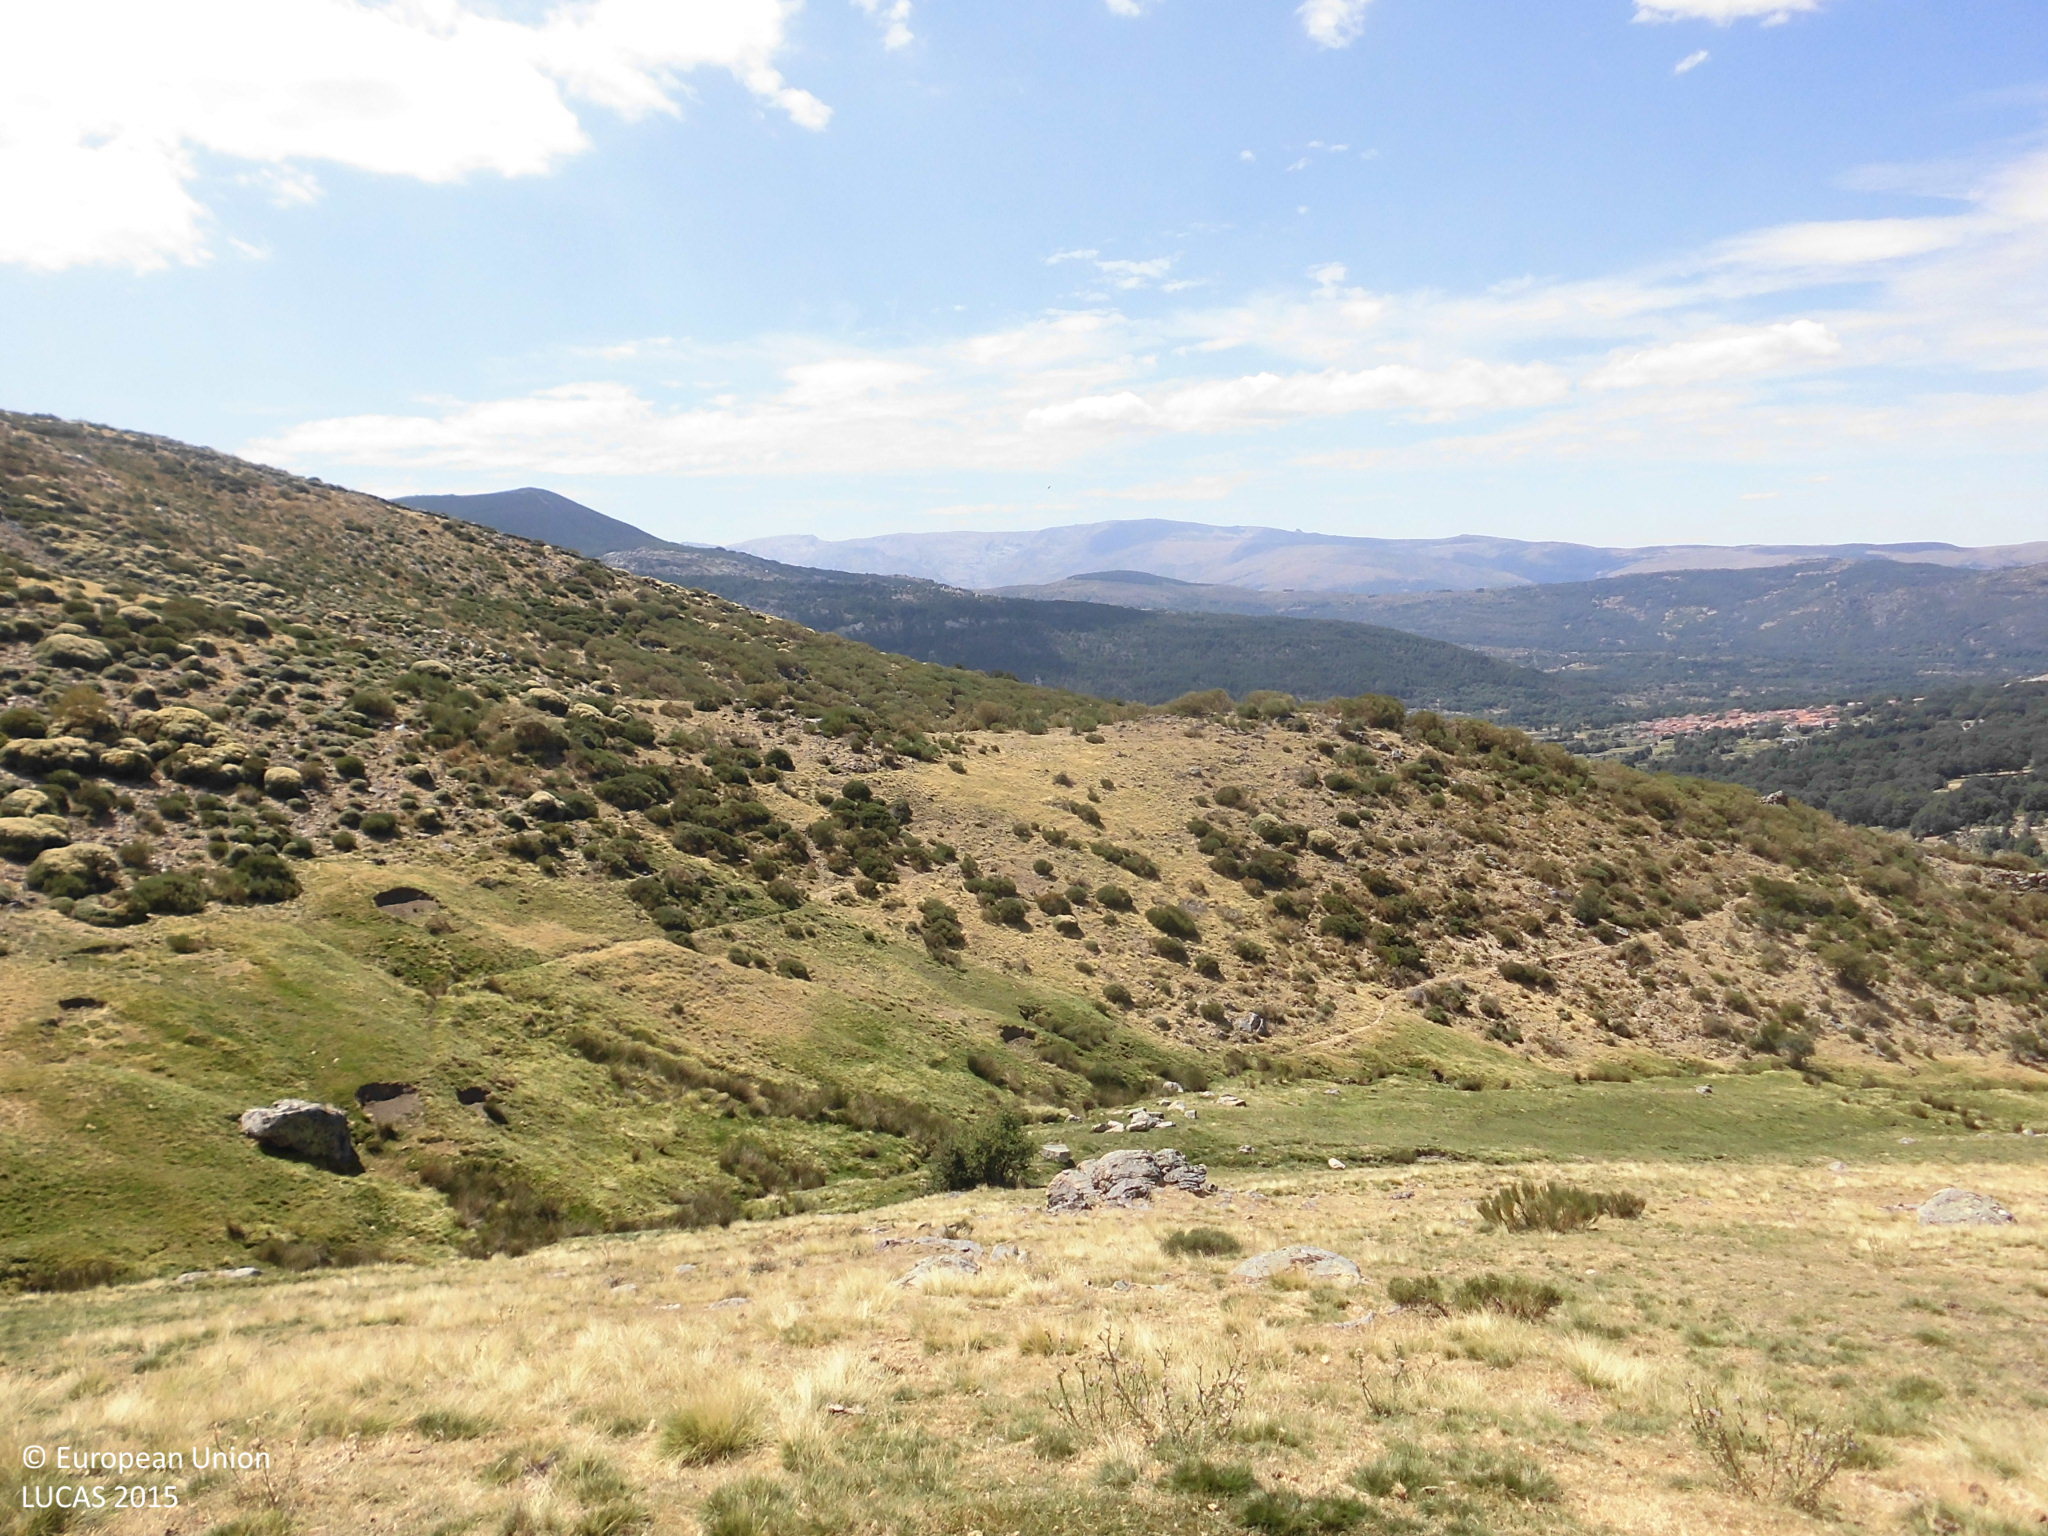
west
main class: Grassland
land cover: Grassland without tree/shrub cover
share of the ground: > 75 %
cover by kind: herbaceous plants 100 %
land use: Agriculture (excluding fallow land and kitchen gardens)
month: July
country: ES
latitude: 40.2620
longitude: -5.4786
